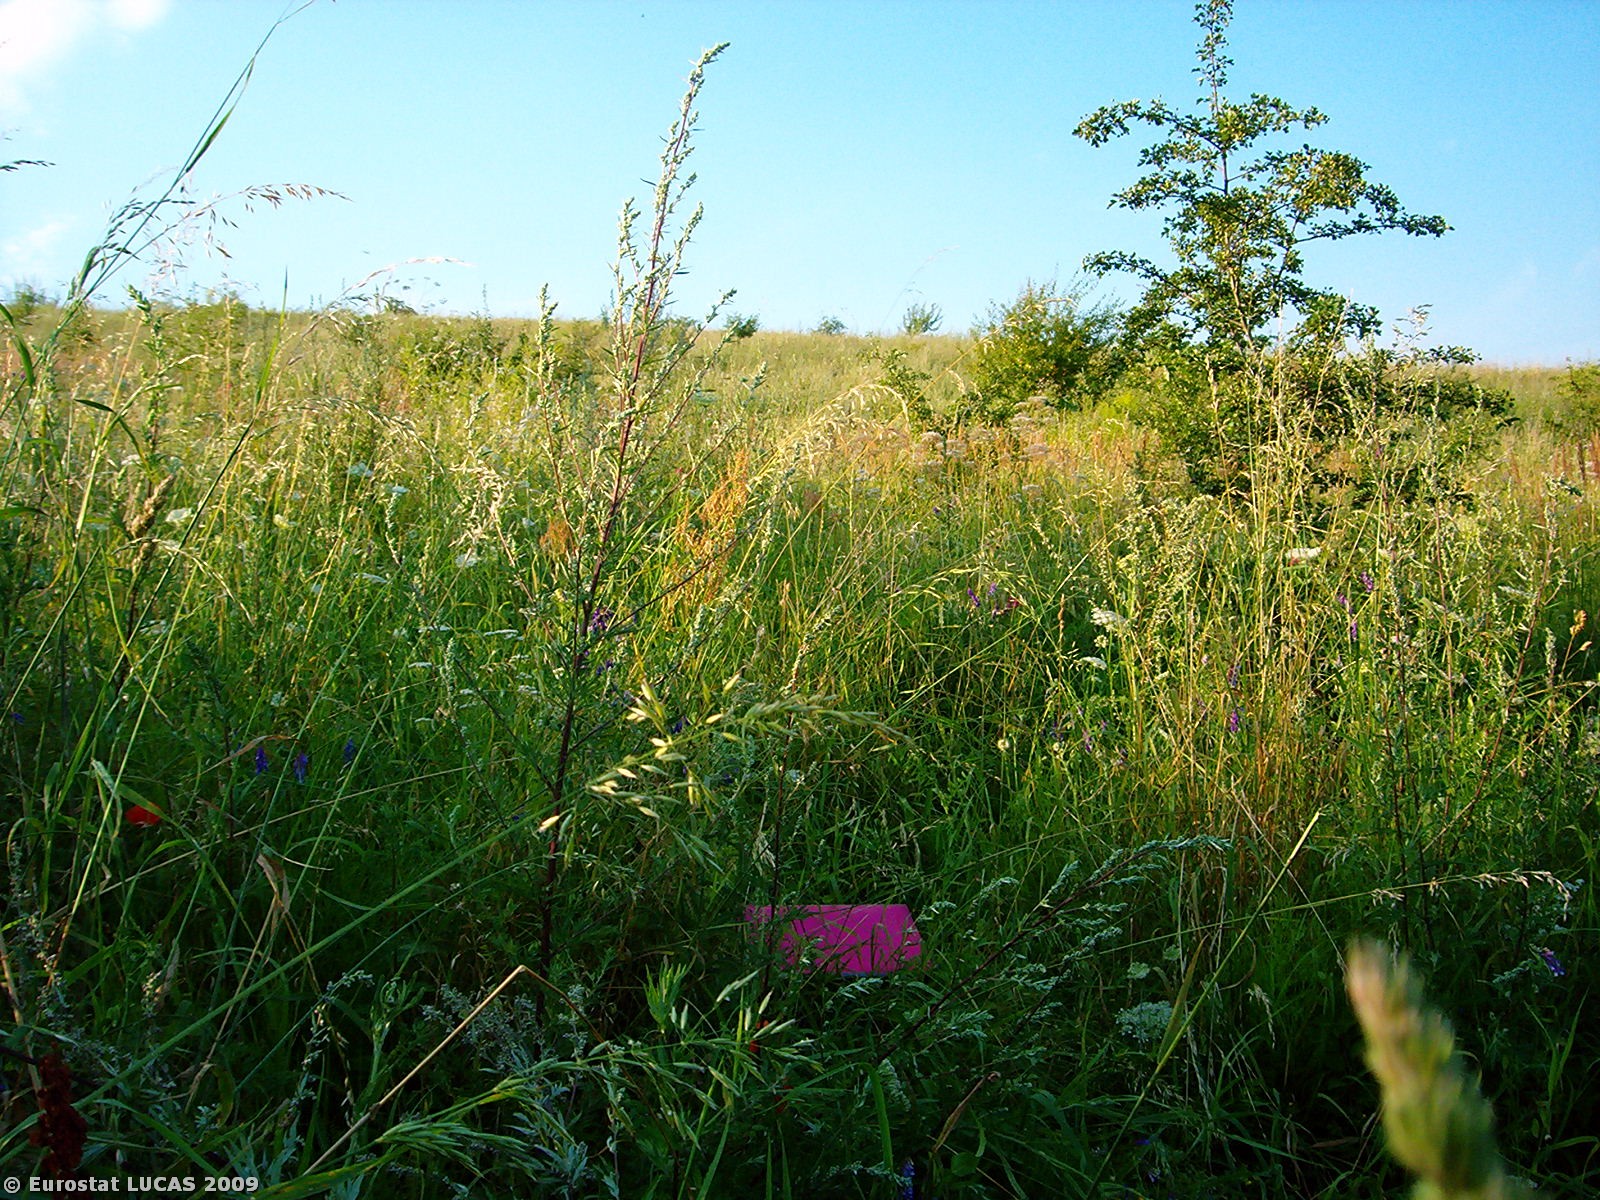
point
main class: Grassland
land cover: Grassland with sparse tree/shrub cover
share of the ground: > 75 %
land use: Unused
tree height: < 5 m
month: July
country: PL
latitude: 52.7406
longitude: 15.4099
